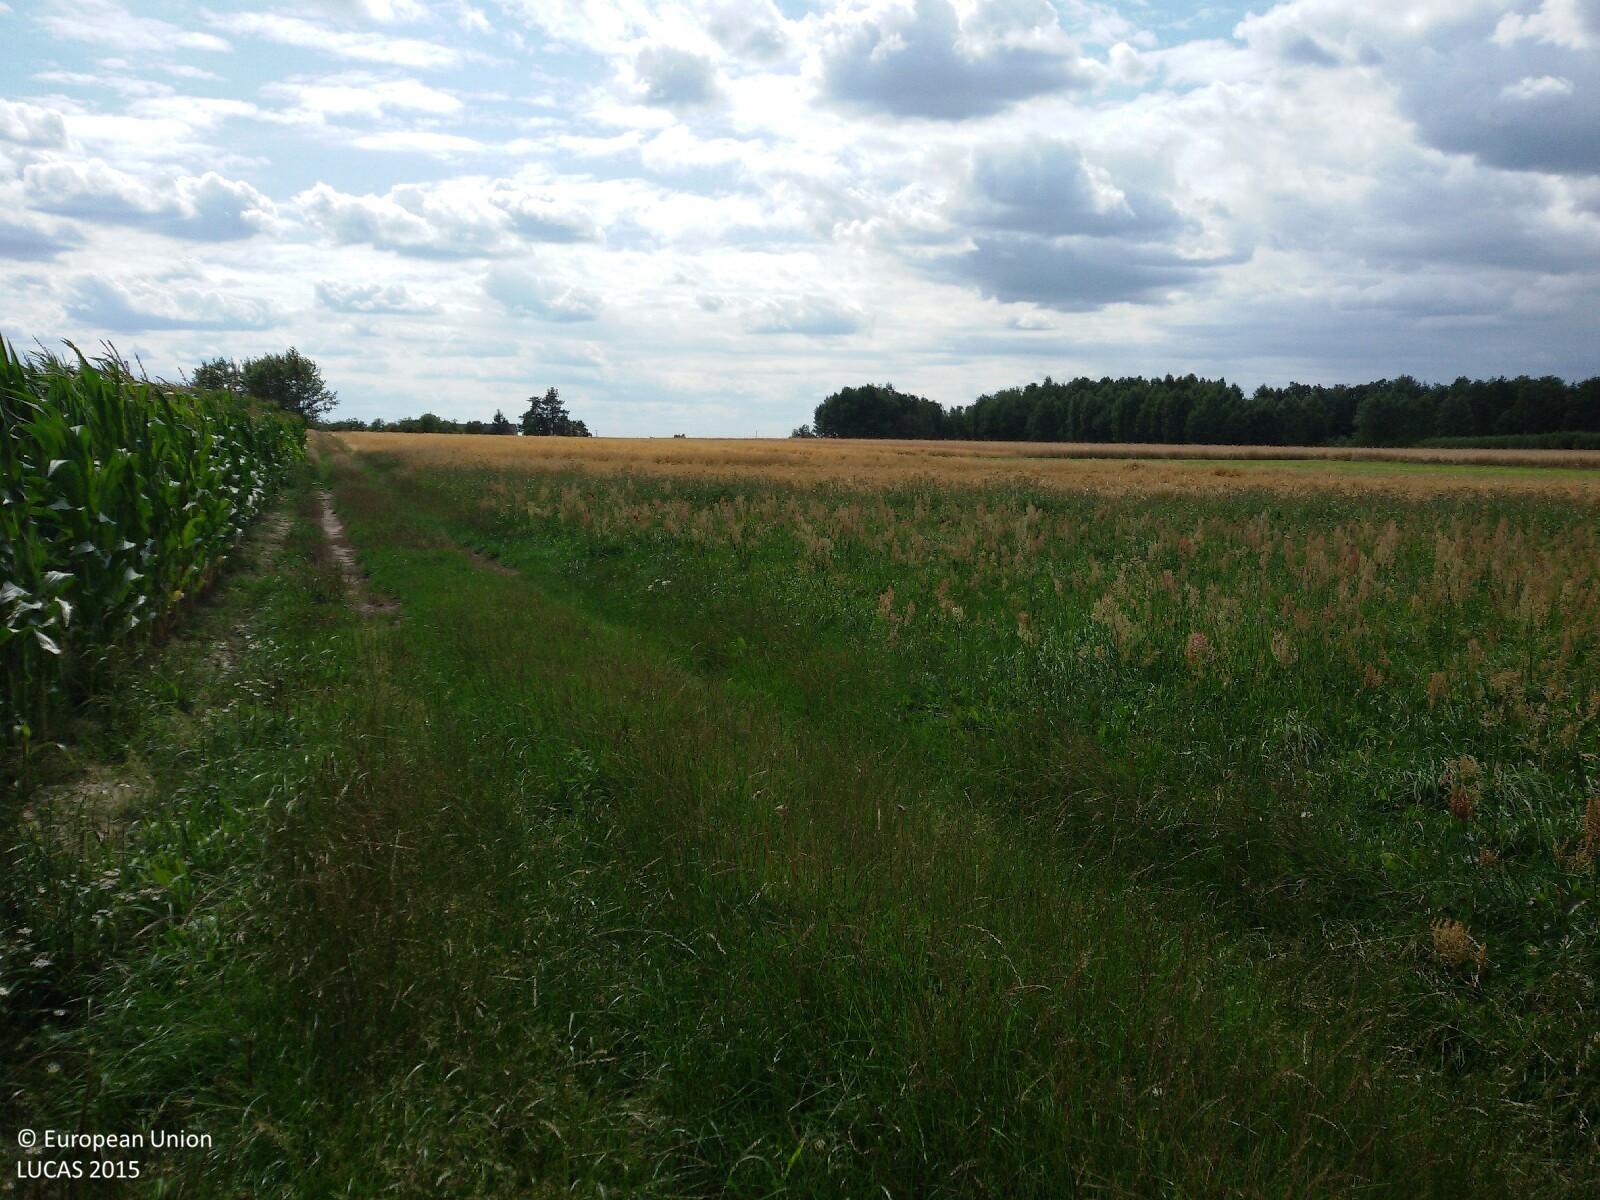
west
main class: Cropland
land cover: Maize
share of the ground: > 75 %
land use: Agriculture (excluding fallow land and kitchen gardens)
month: July
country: PL
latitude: 52.0447
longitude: 21.7629
